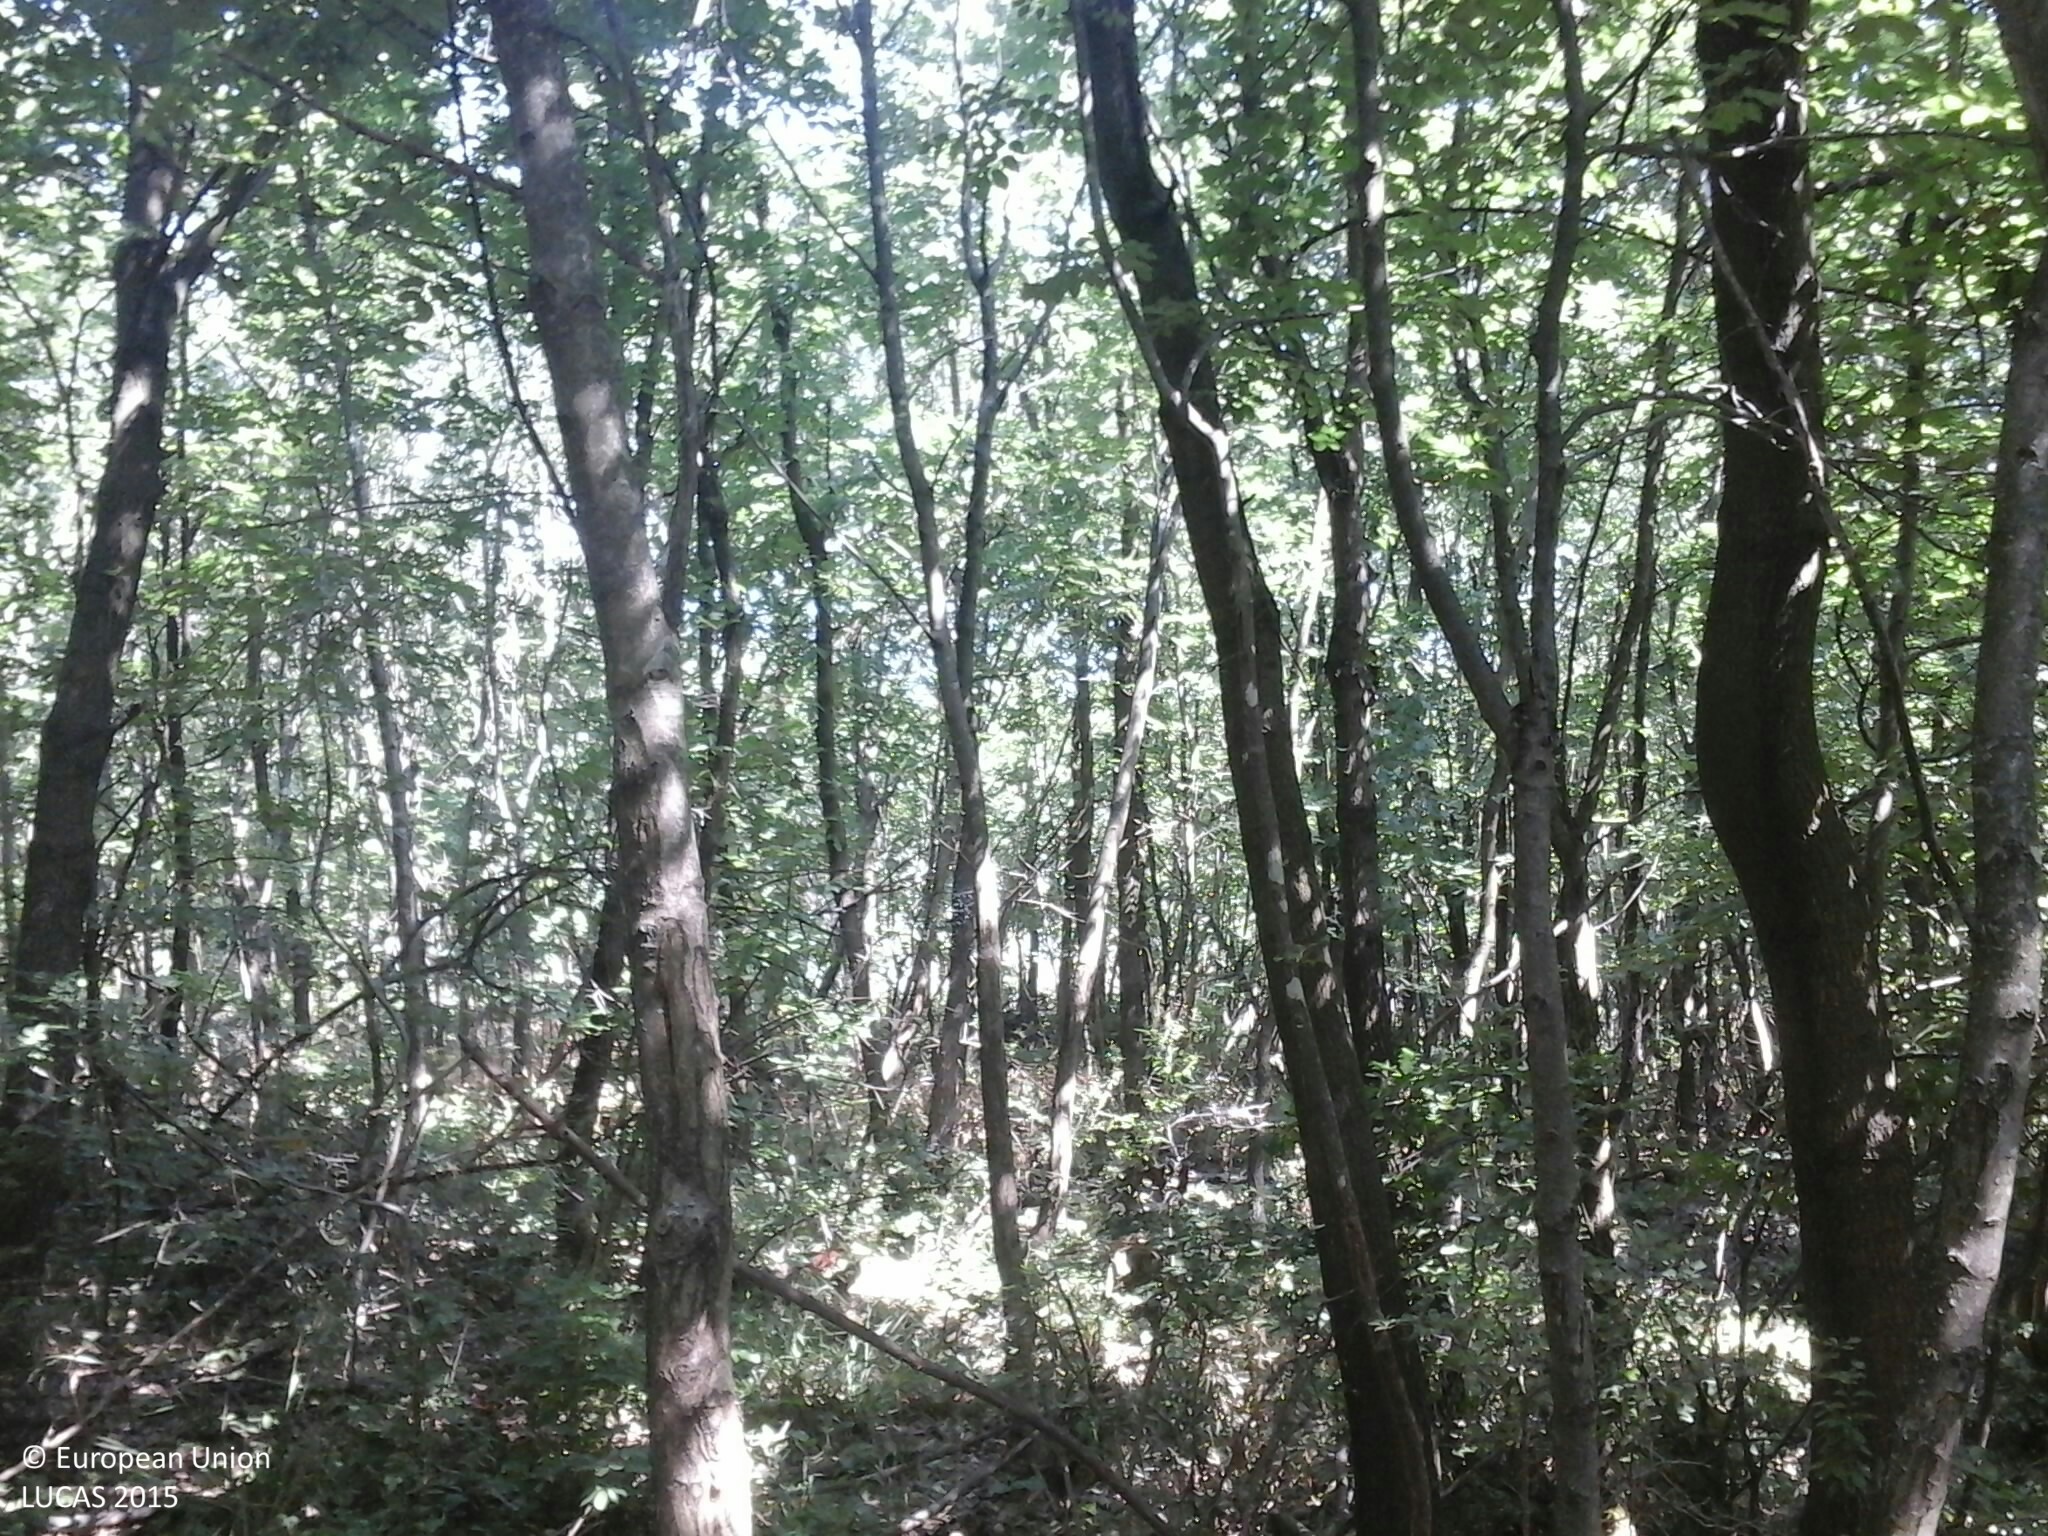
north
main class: Woodland
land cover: Broadleaved woodland
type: exotic forest
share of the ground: > 75 %
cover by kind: broadleaved forest trees 100 %
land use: Forestry
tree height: > 5 m
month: July
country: HU
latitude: 47.0362
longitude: 17.8915
